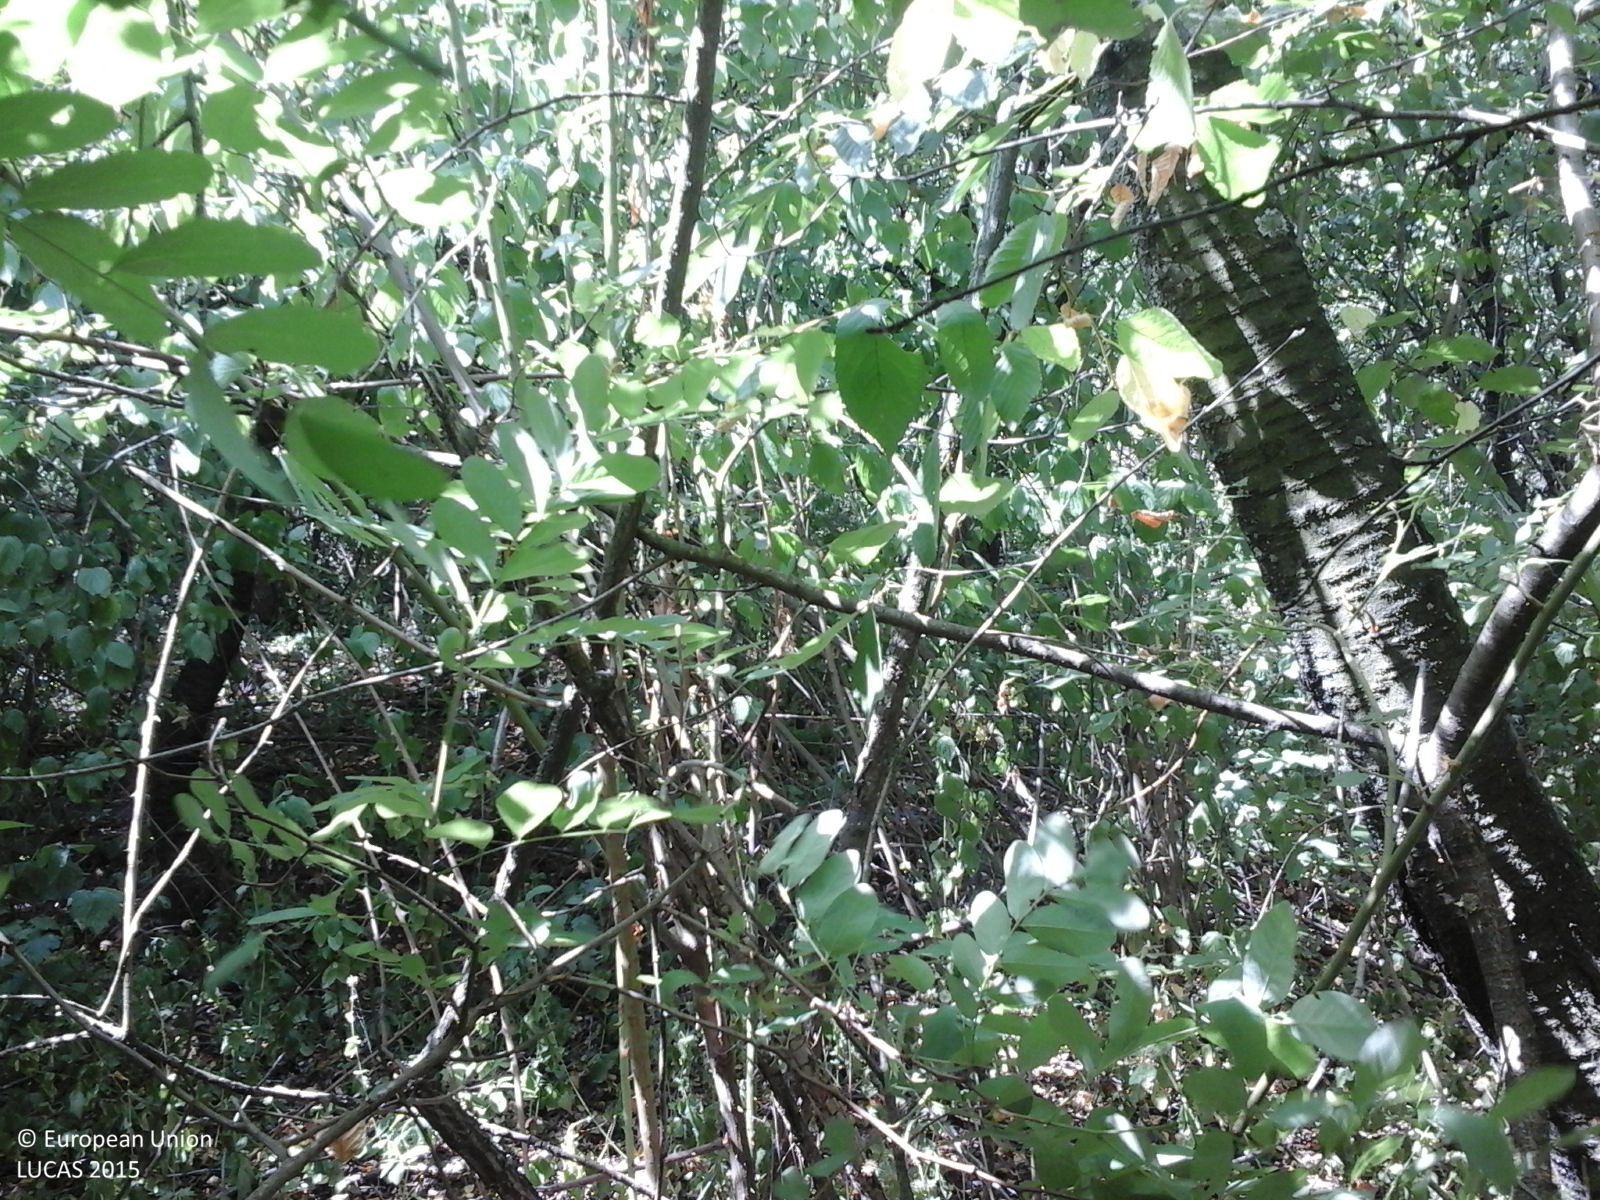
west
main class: Woodland
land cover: Broadleaved woodland
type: mesophytic deciduous forest
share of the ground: > 75 %
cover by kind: broadleaved forest trees 85 %, shrubs 10 %, herbaceous plants 5 %
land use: Forestry
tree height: > 5 m
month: July
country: RO
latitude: 46.2737
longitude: 27.6179
